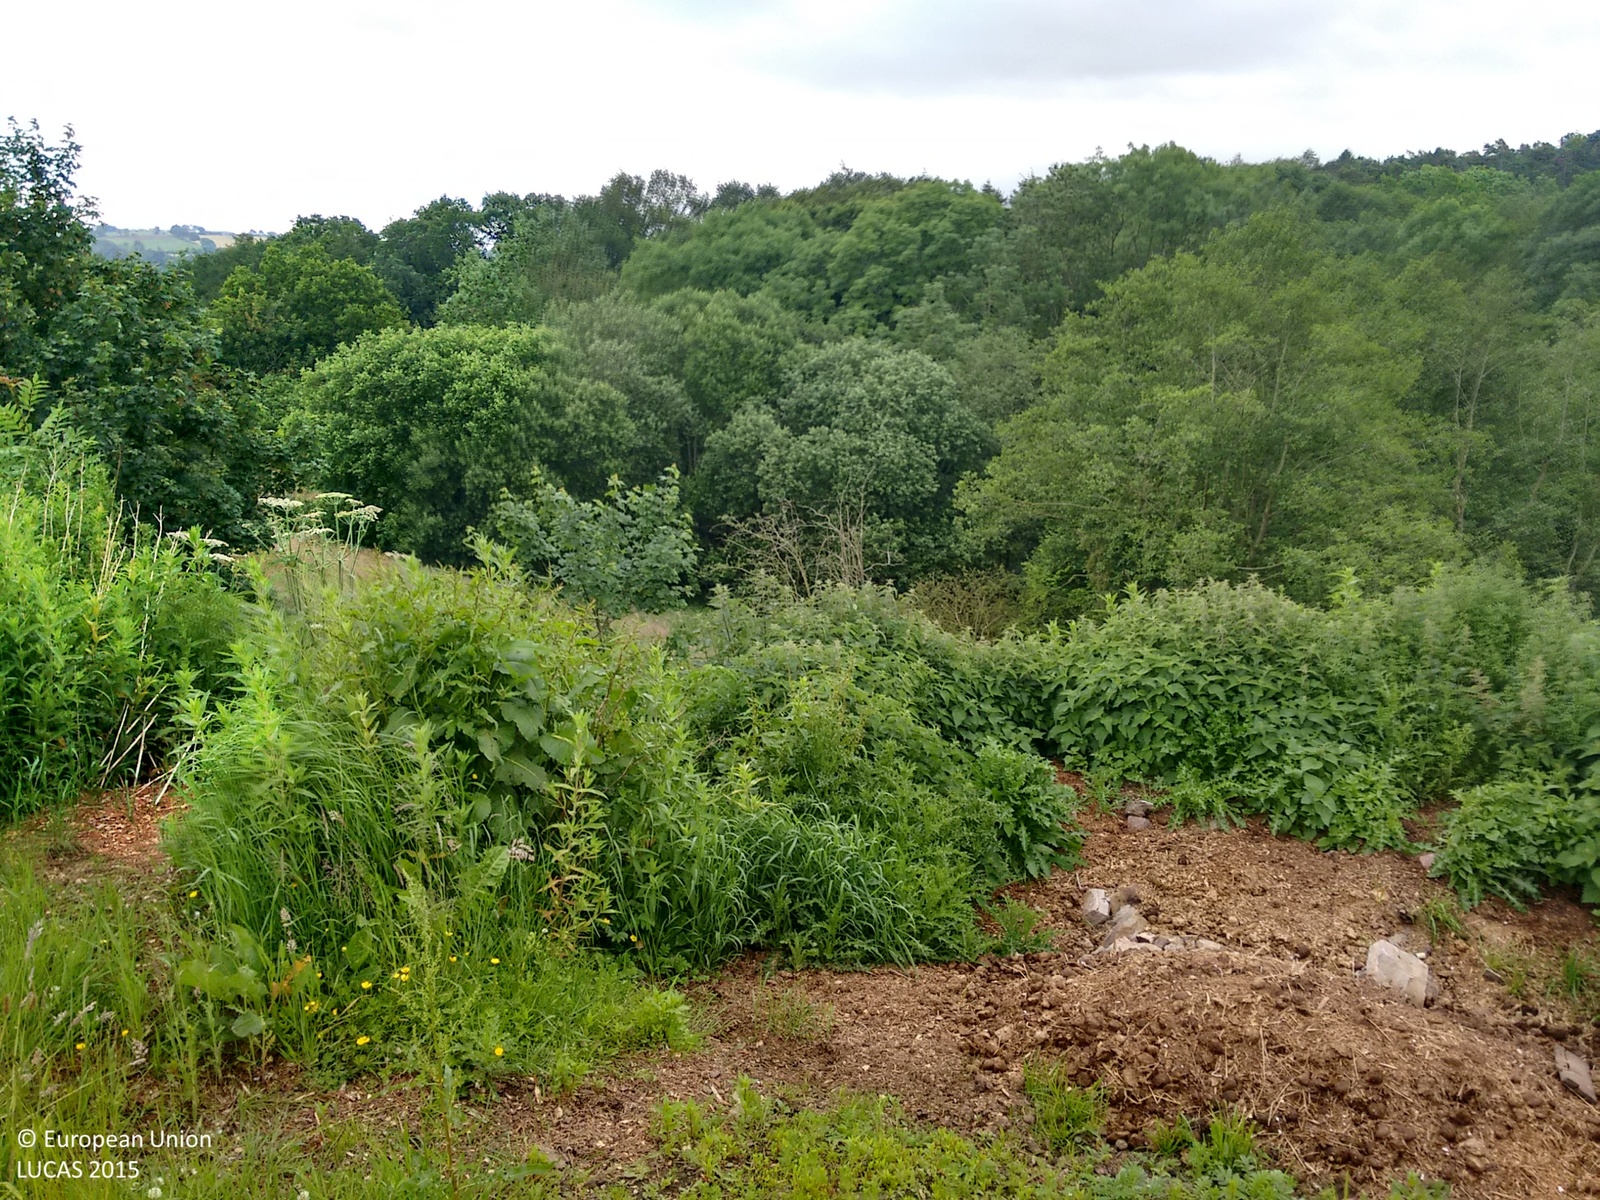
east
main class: Grassland
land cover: Spontaneously vegetated surfaces
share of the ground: 50 - 75 %
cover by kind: herbaceous plants 100 %
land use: Agriculture (excluding fallow land and kitchen gardens)
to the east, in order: Spontaneously vegetated surfaces; Other bare soil; Grassland without tree/shrub cover; Electric lines; Grassland without tree/shrub cover; Broadleaved woodland; Rivers and streams; Broadleaved woodland; Grassland without tree/shrub cover
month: June
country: GB
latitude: 55.7340
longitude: -3.9259
